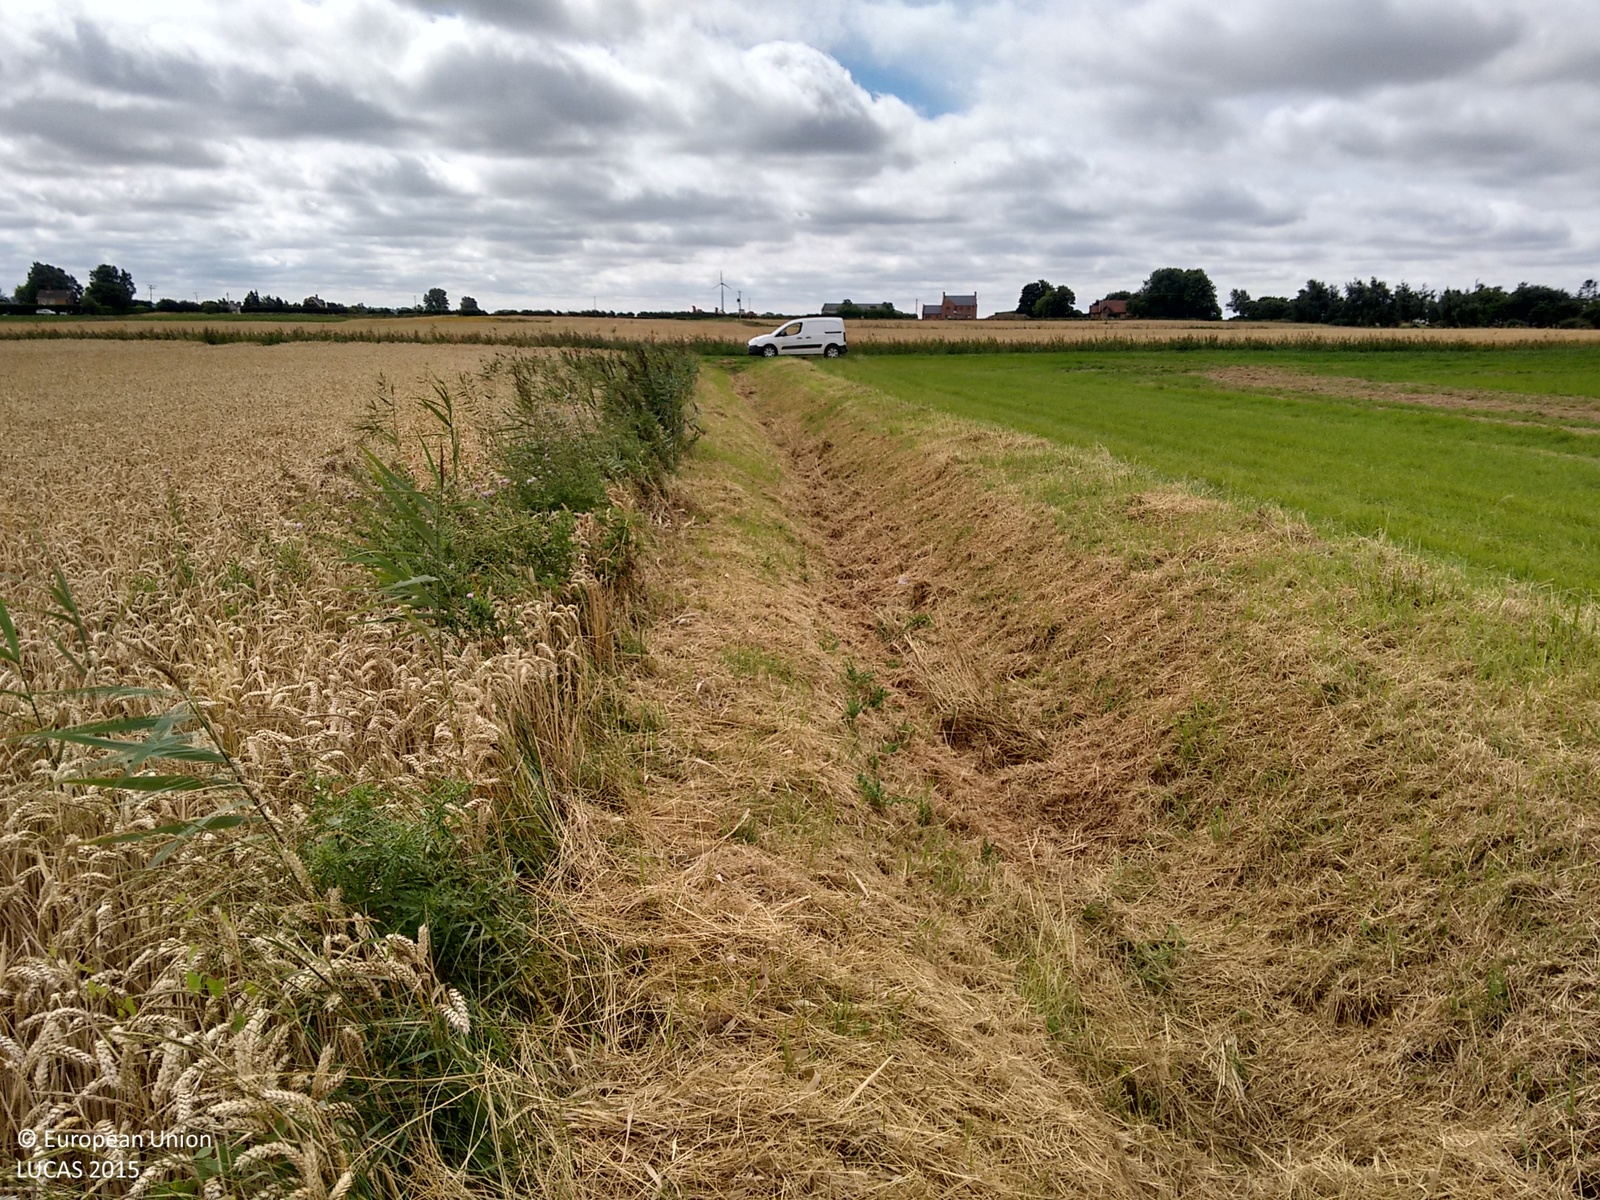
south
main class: Cropland
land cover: Common wheat
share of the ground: > 75 %
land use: Agriculture (excluding fallow land and kitchen gardens)
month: August
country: GB
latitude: 52.6356
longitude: 0.3517
